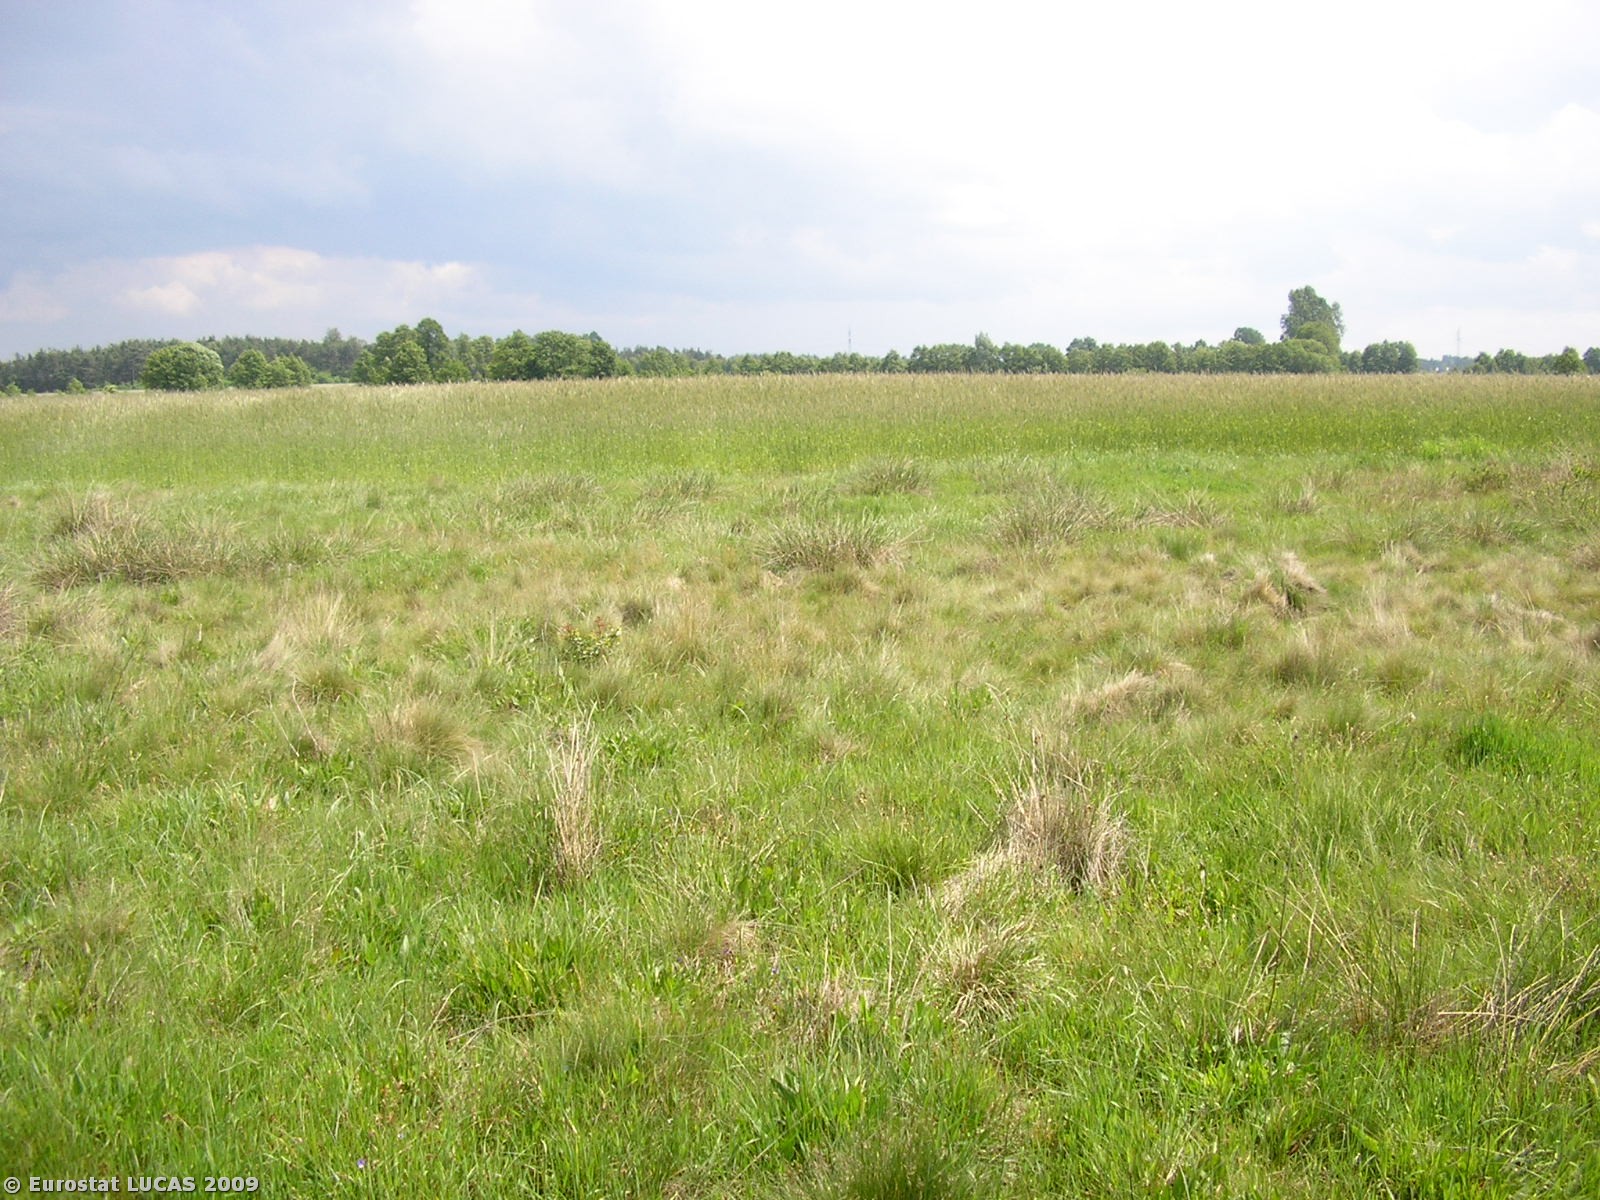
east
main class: Grassland
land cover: Grassland without tree/shrub cover
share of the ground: > 75 %
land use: Fallow land
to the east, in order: Grassland without tree/shrub cover; Rye; Grass margins; Rye; Grassland without tree/shrub cover; Triticale; Grass margins; Barley; Grassland without tree/shrub cover; Triticale; Grassland without tree/shrub cover
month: June
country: PL
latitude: 51.4057
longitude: 18.9503
